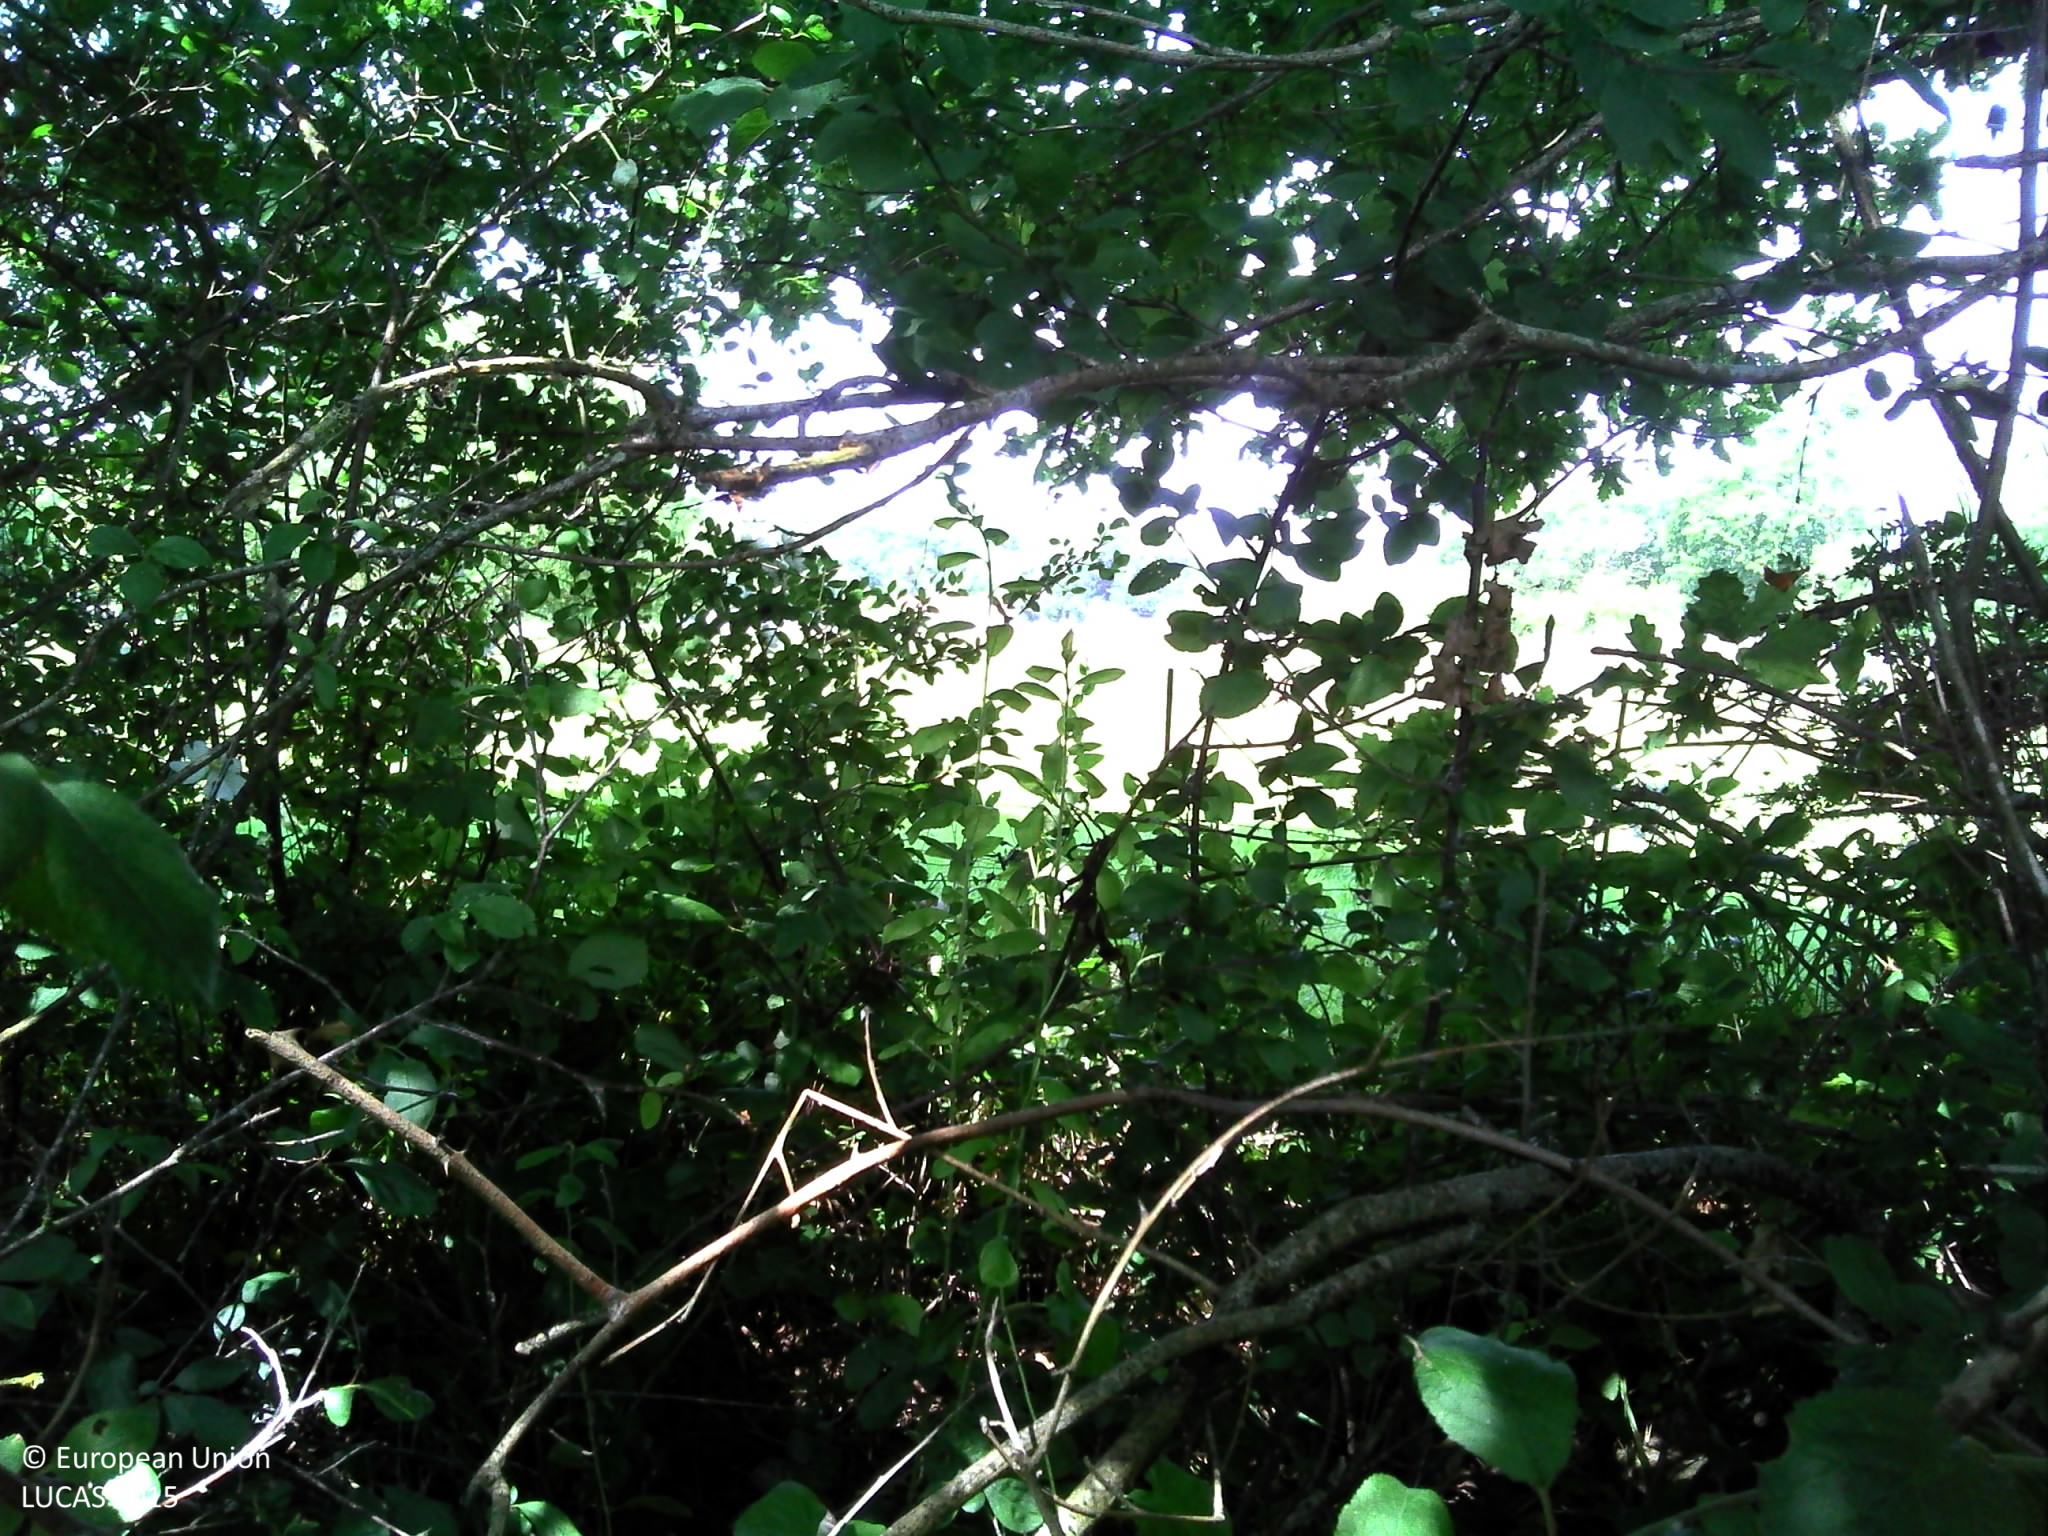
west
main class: Woodland
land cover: Broadleaved woodland
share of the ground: > 75 %
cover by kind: broadleaved forest trees 95 %, shrubs 5 %
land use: Semi-natural and natural areas not in use
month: June
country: FR
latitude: 47.1468
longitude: -1.5008
